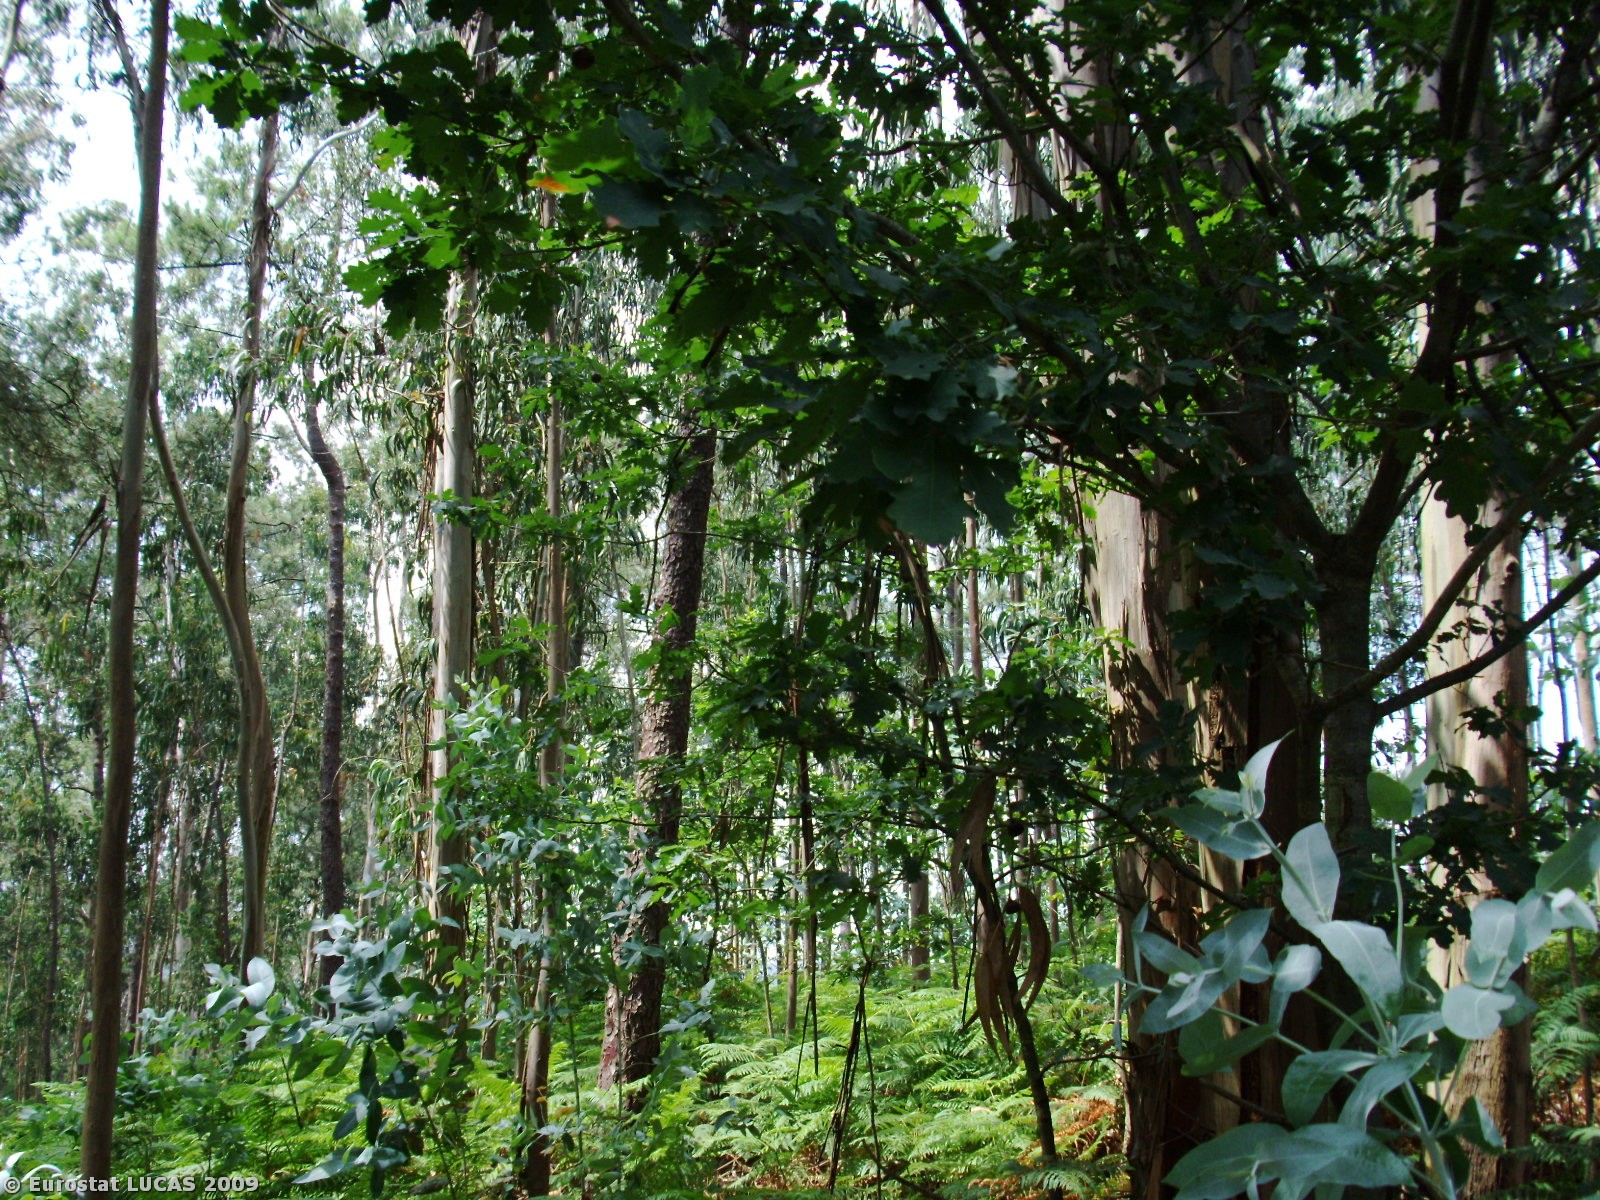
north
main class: Woodland
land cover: Broadleaved woodland
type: plantations and self-sown exotic forest
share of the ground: 50 - 75 %
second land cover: Spontaneously vegetated surfaces
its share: 50 - 75 %
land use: Forestry
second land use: Unused
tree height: > 5 m
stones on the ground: < 10 %
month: June
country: PT
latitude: 41.4357
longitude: -8.4759
